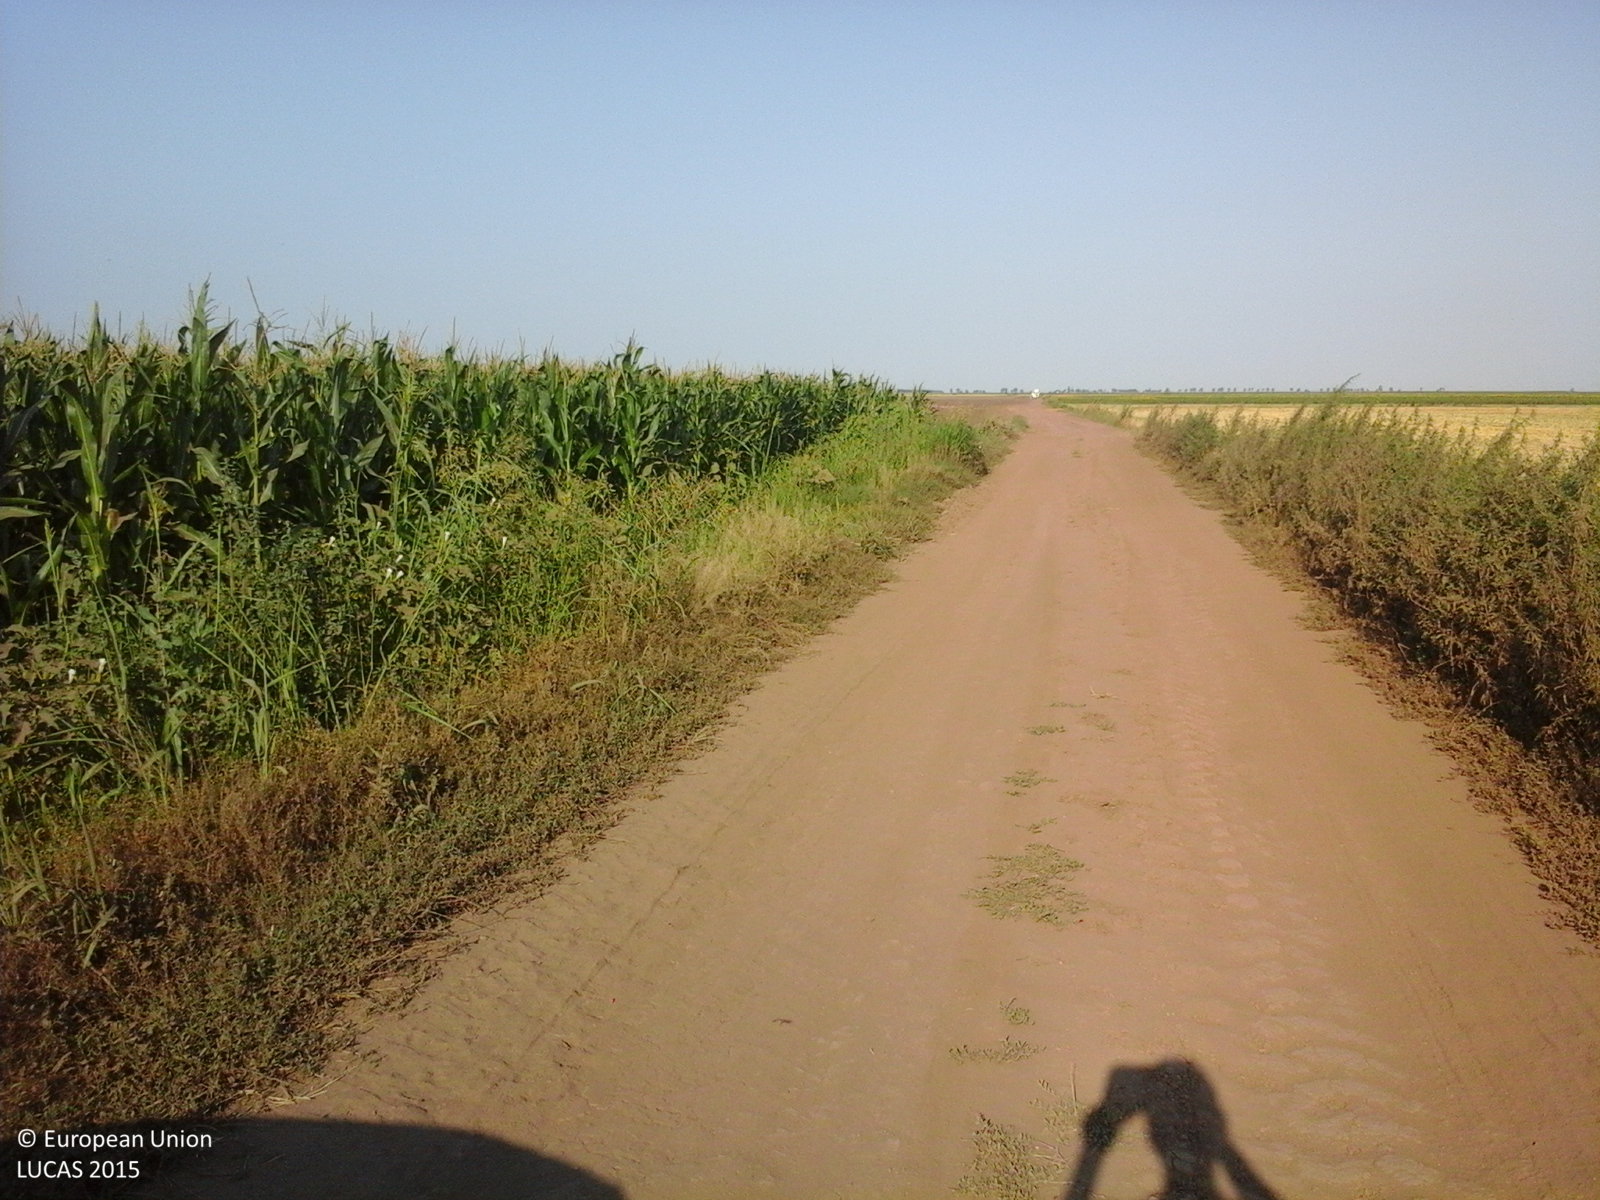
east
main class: Cropland
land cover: Maize
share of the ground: > 75 %
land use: Agriculture (excluding fallow land and kitchen gardens)
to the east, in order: Maize; Other bare soil; Rape and turnip rape
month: July
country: RO
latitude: 44.6648
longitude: 27.3308
